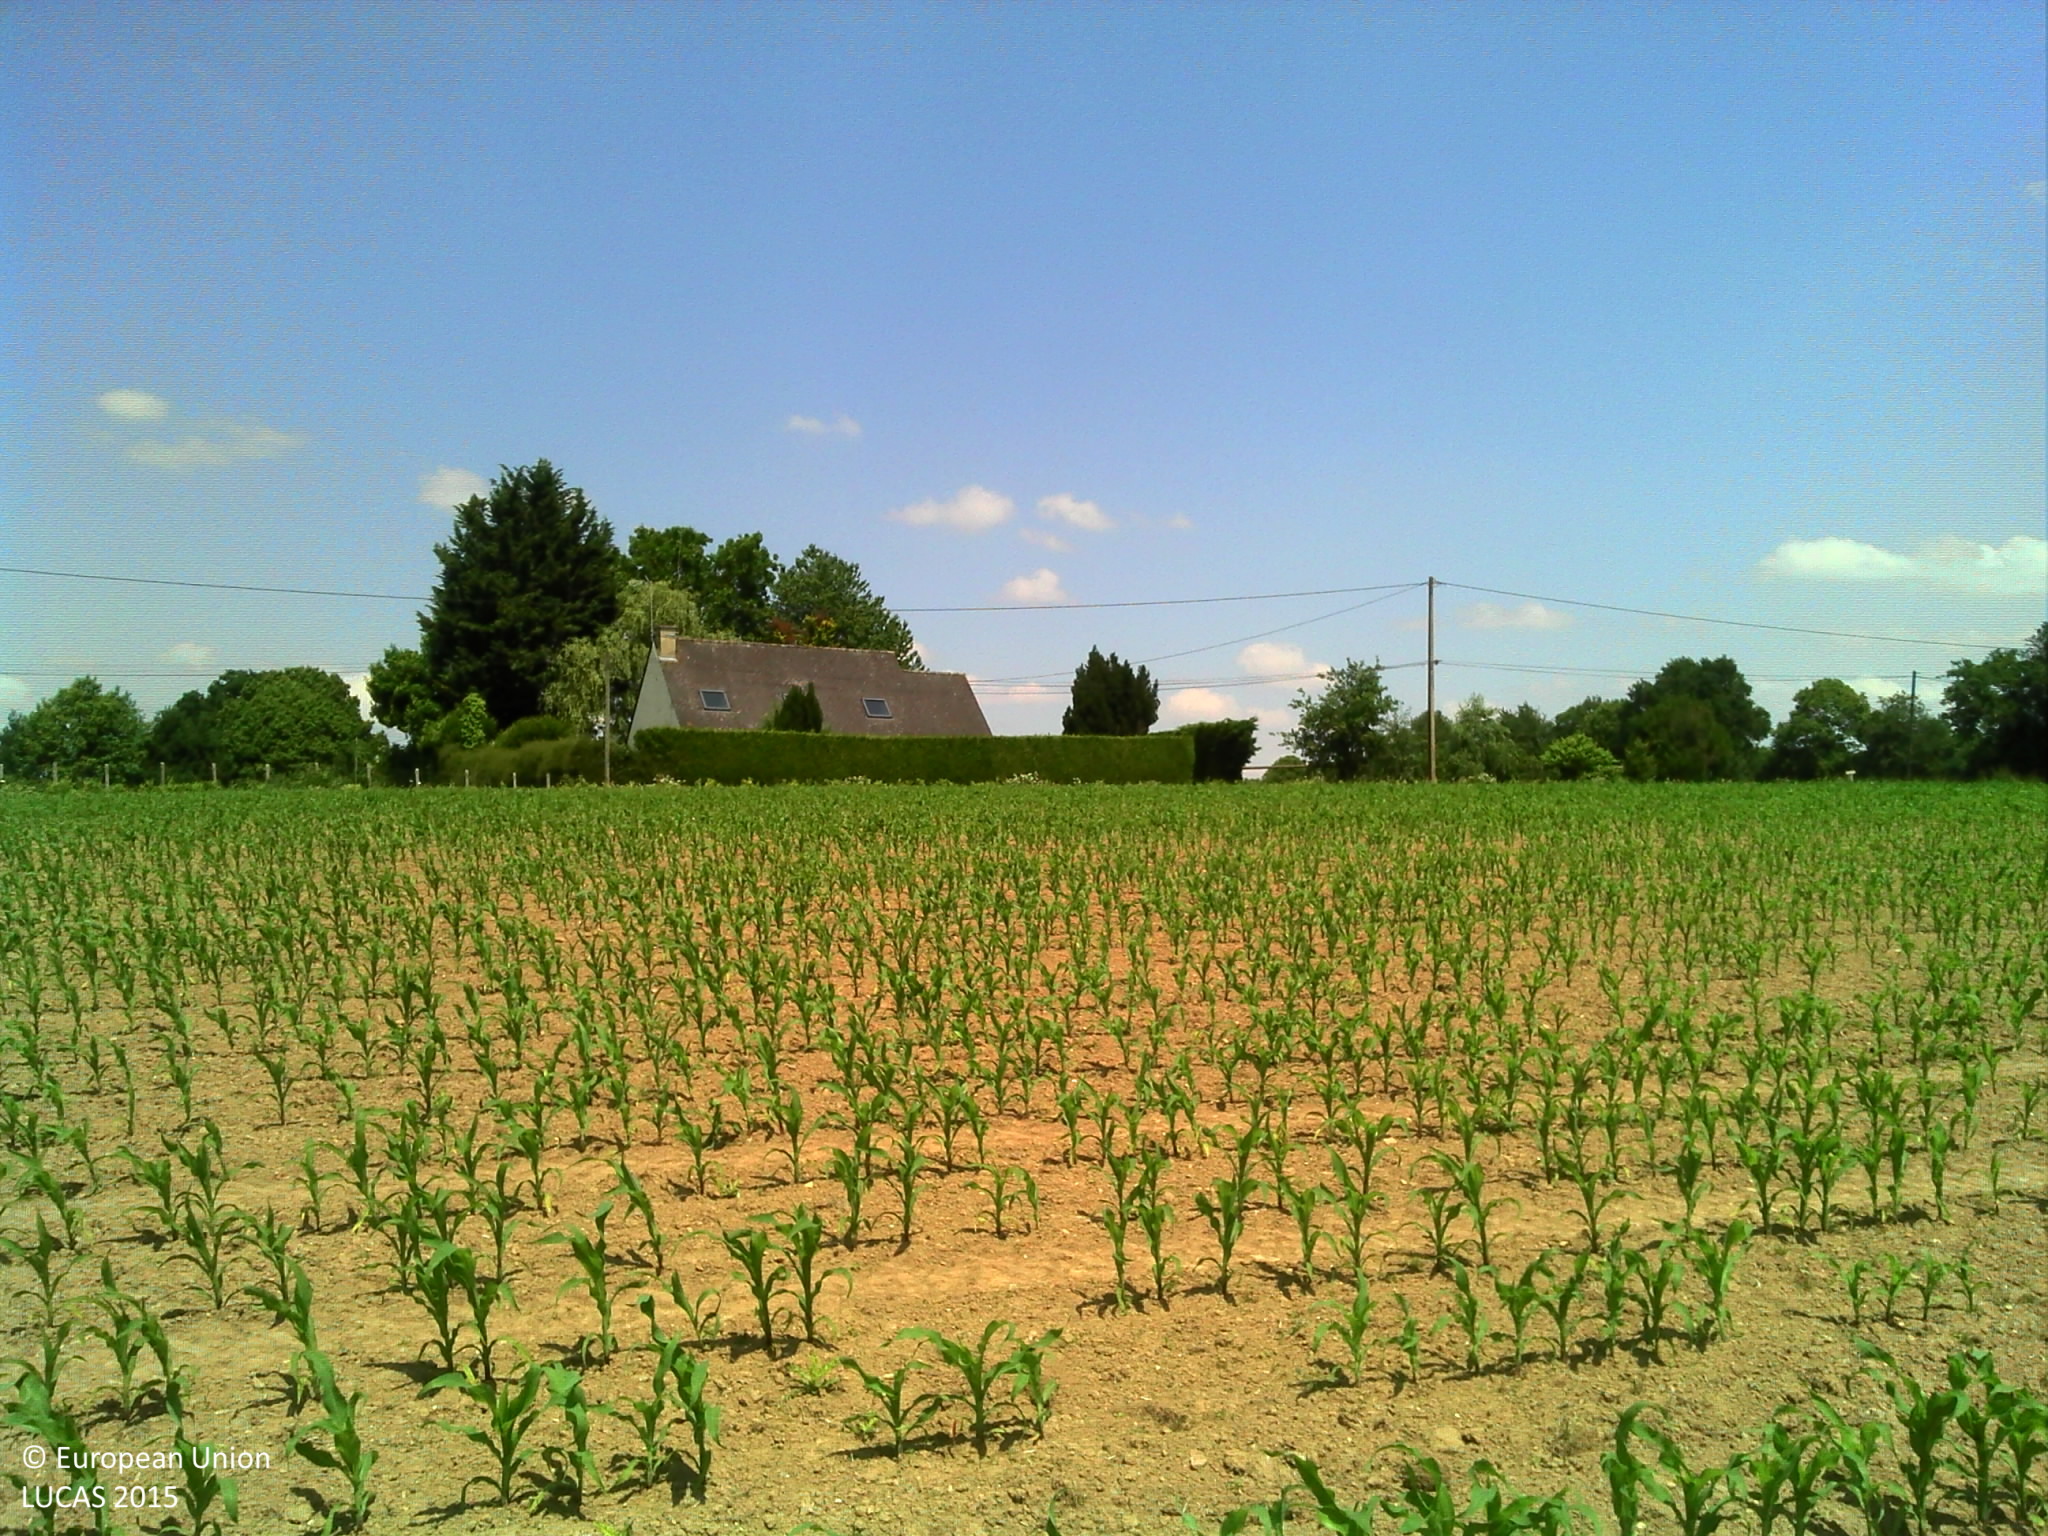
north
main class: Cropland
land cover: Maize
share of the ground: < 10 %
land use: Agriculture (excluding fallow land and kitchen gardens)
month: June
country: FR
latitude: 48.1129
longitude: -1.1221
